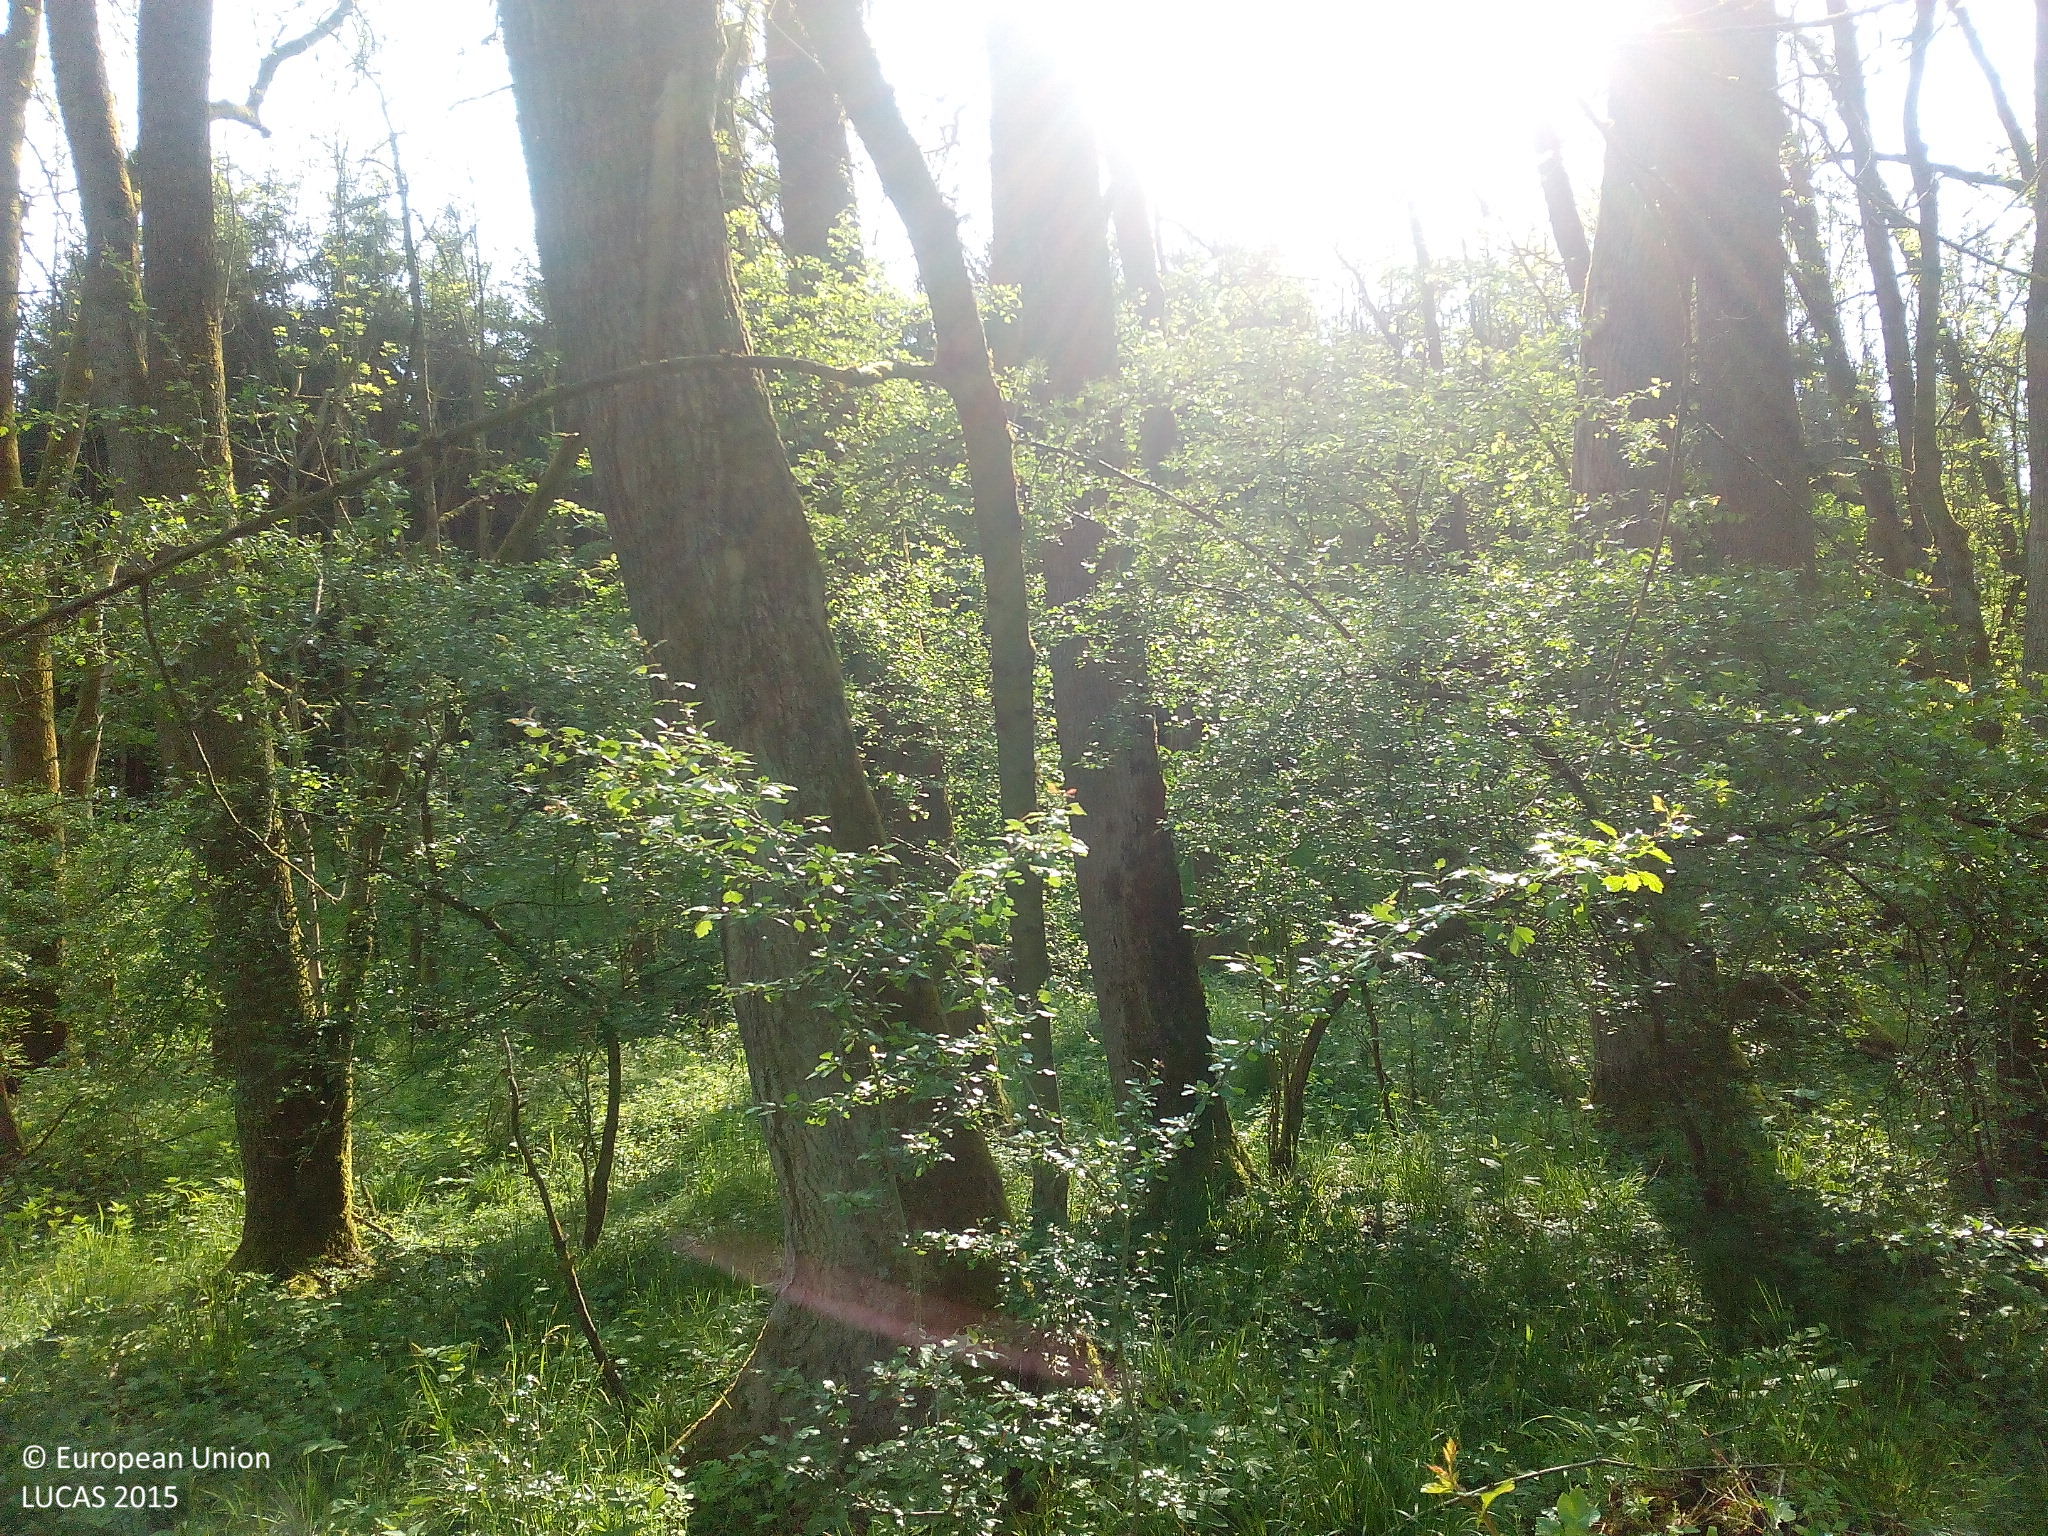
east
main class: Woodland
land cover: Broadleaved woodland
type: mesophytic deciduous forest
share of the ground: > 75 %
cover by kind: broadleaved forest trees 90 %, shrubs 5 %, herbaceous plants 5 %
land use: Forestry
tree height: > 5 m
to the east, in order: Broadleaved woodland; Rivers and streams; Broadleaved woodland; Spruce dominated coniferous woodland; Grassland without tree/shrub cover; Tracks; Grass margins; Clovers; Grassland without tree/shrub cover
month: May
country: DE
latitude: 49.8688
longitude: 11.4883
